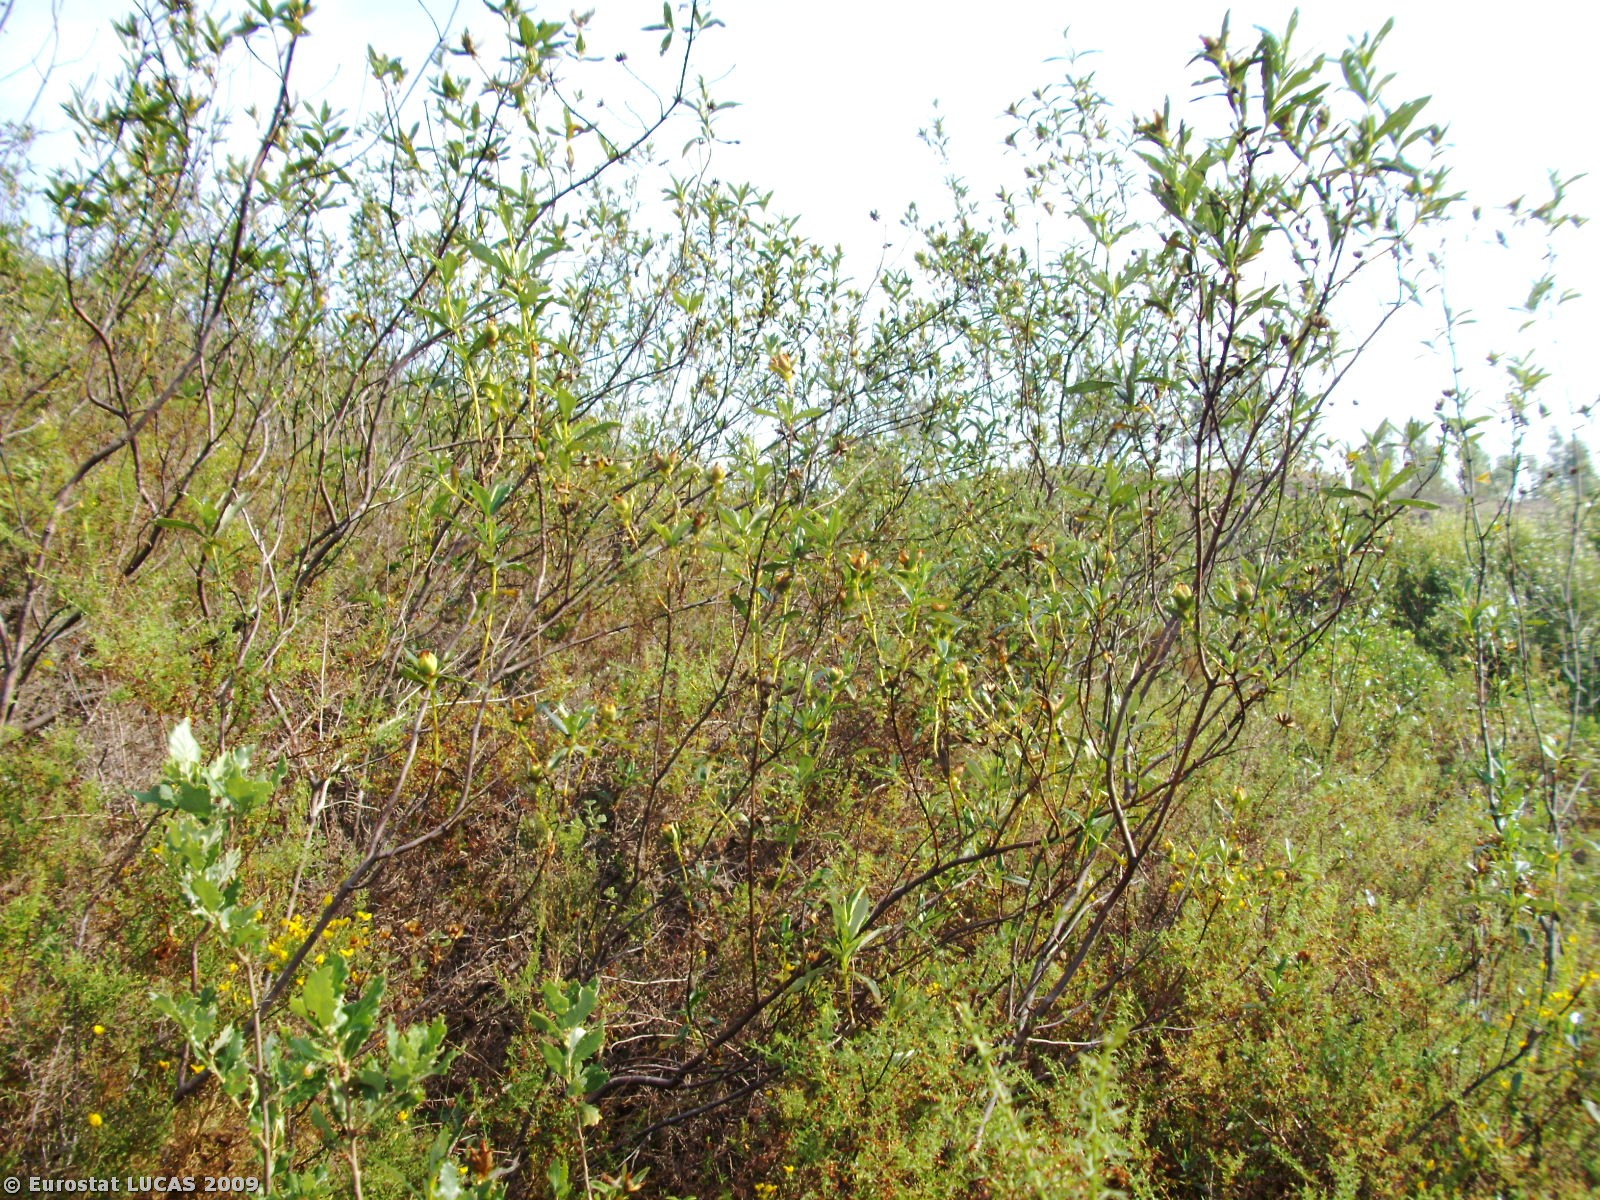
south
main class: Shrubland
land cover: Shrubland without tree cover
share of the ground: > 75 %
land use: Unused
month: June
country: PT
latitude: 37.3850
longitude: -8.7508
